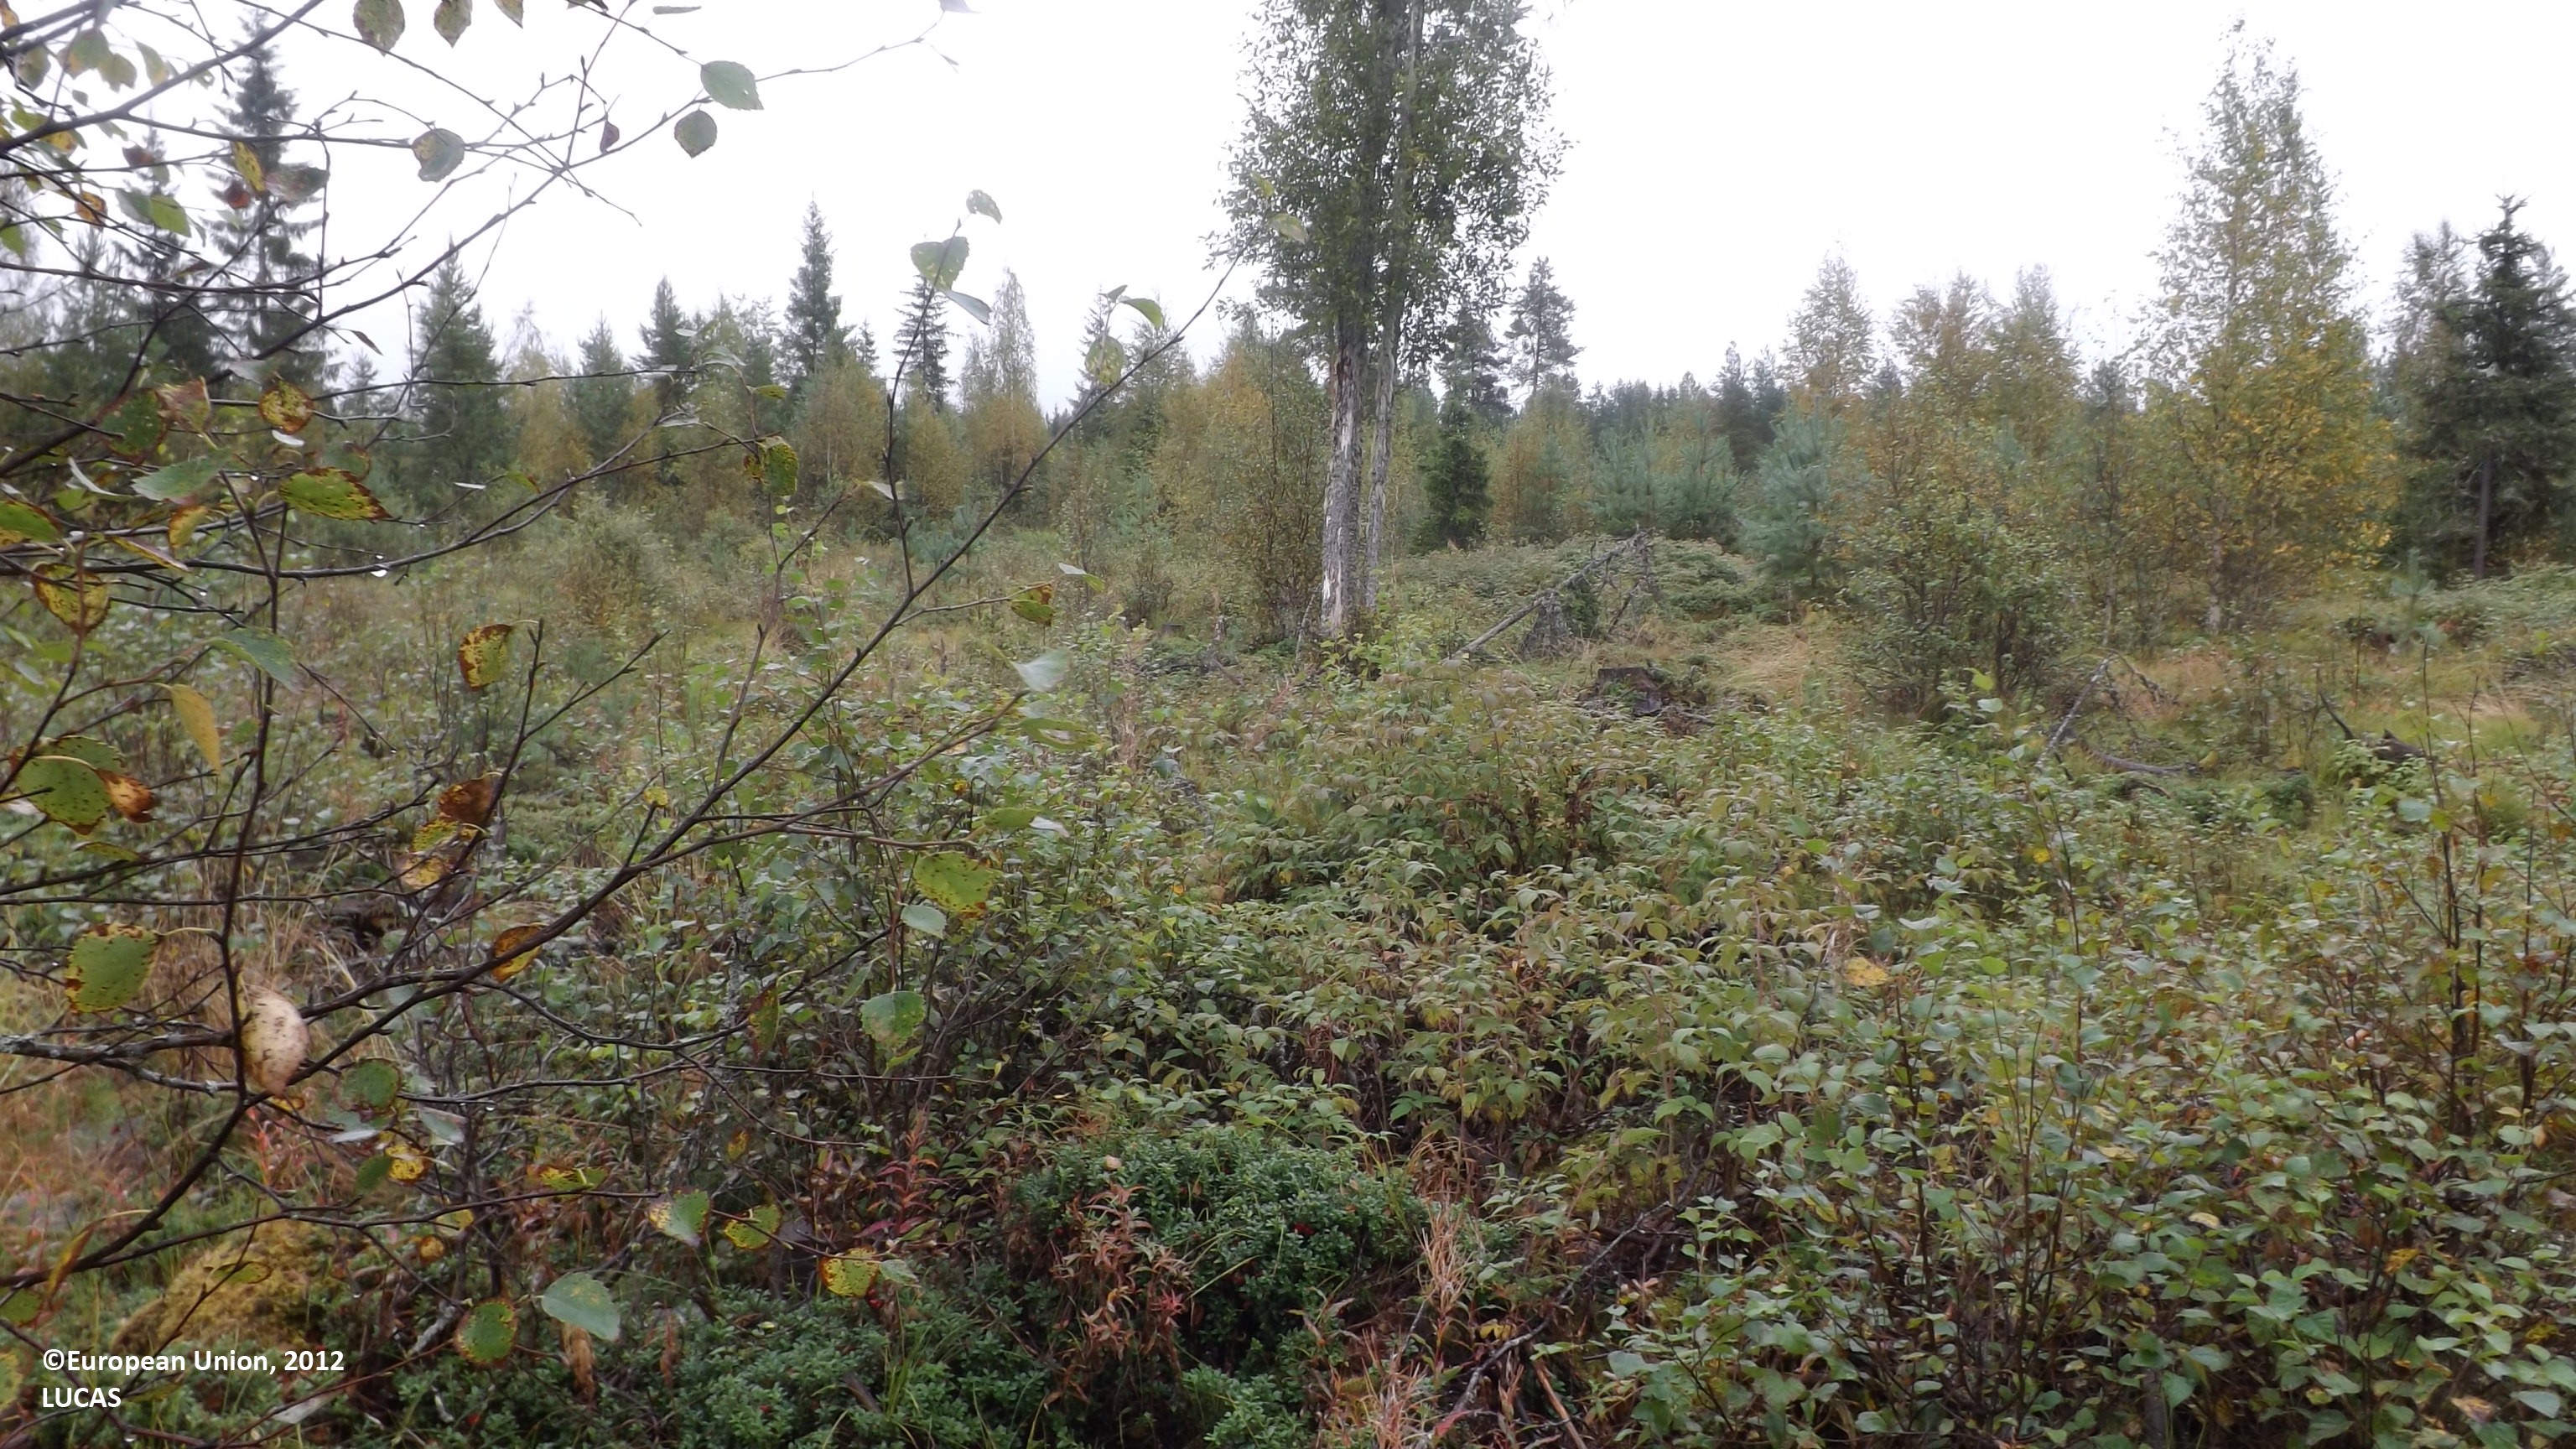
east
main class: Shrubland
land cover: Shrubland with sparse tree cover
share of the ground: 50 - 75 %
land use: Forestry
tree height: < 5 m
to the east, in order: Shrubland with sparse tree cover; Pine dominated coniferous woodland; Ditches and canals; Shrubland with sparse tree cover; Broadleaved woodland; Ditches and canals; Pine dominated mixed woodland; Ditches and canals; Pine dominated mixed woodland; Ditches and canals; Spruce dominated mixed woodland; Ditches and canals; Pine dominated mixed woodland
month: August
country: FI
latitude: 63.8053
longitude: 23.6452
